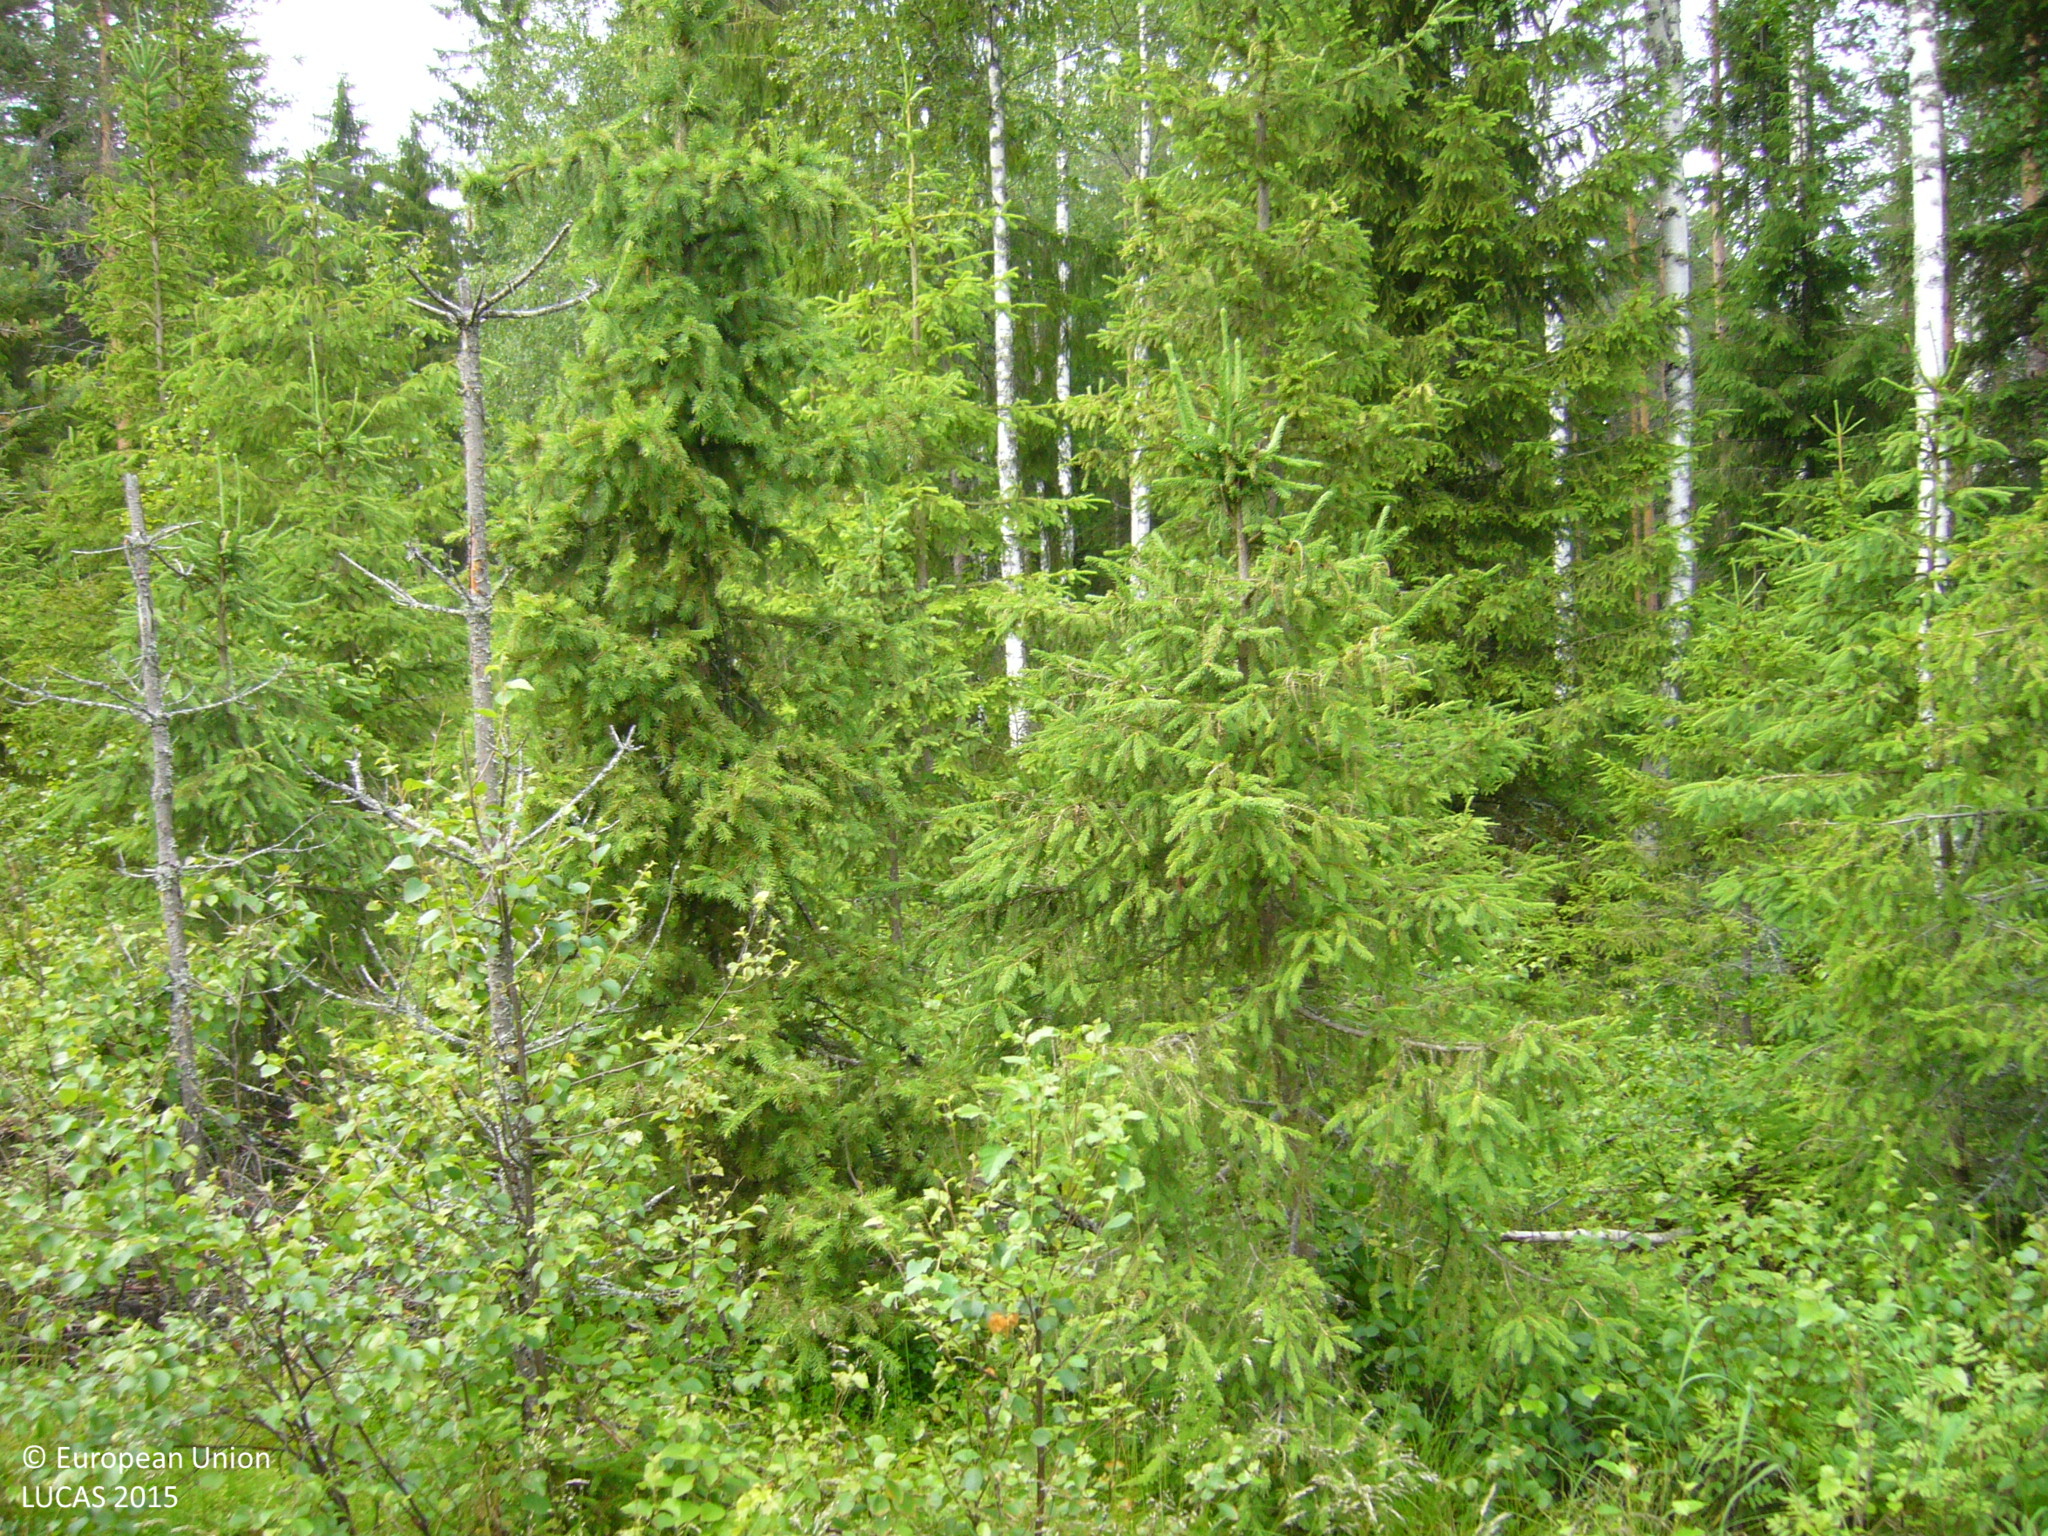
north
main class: Woodland
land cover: Spruce dominated mixed woodland
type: boreal forest
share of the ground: 50 - 75 %
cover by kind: shrubs 45 %, coniferous forest trees 30 %, broadleaved forest trees 25 %
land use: Forestry
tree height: > 5 m
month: July
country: FI
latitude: 63.5074
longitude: 25.4307
